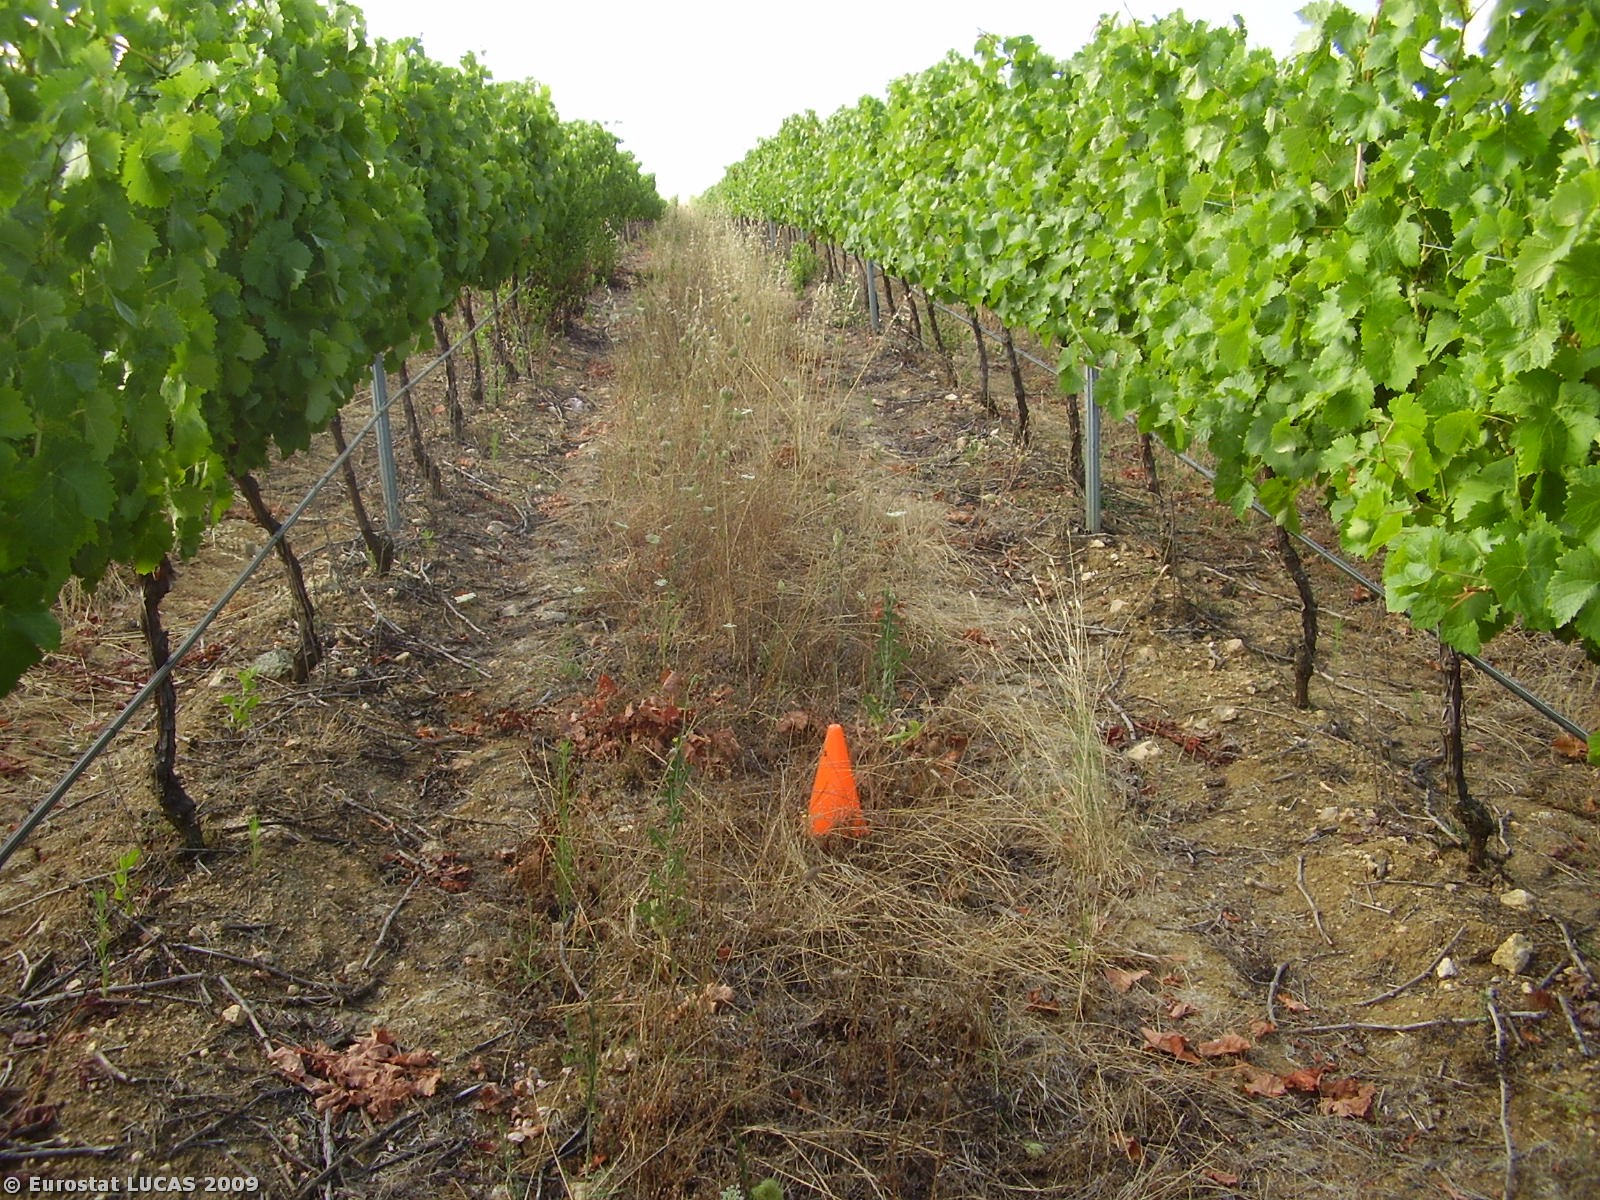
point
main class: Cropland
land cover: Vineyards
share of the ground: 25 - 50 %
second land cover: Spontaneously vegetated surfaces
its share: 50 - 75 %
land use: Agriculture (excluding fallow land and kitchen gardens)
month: July
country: PT
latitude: 38.7823
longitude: -7.9448
